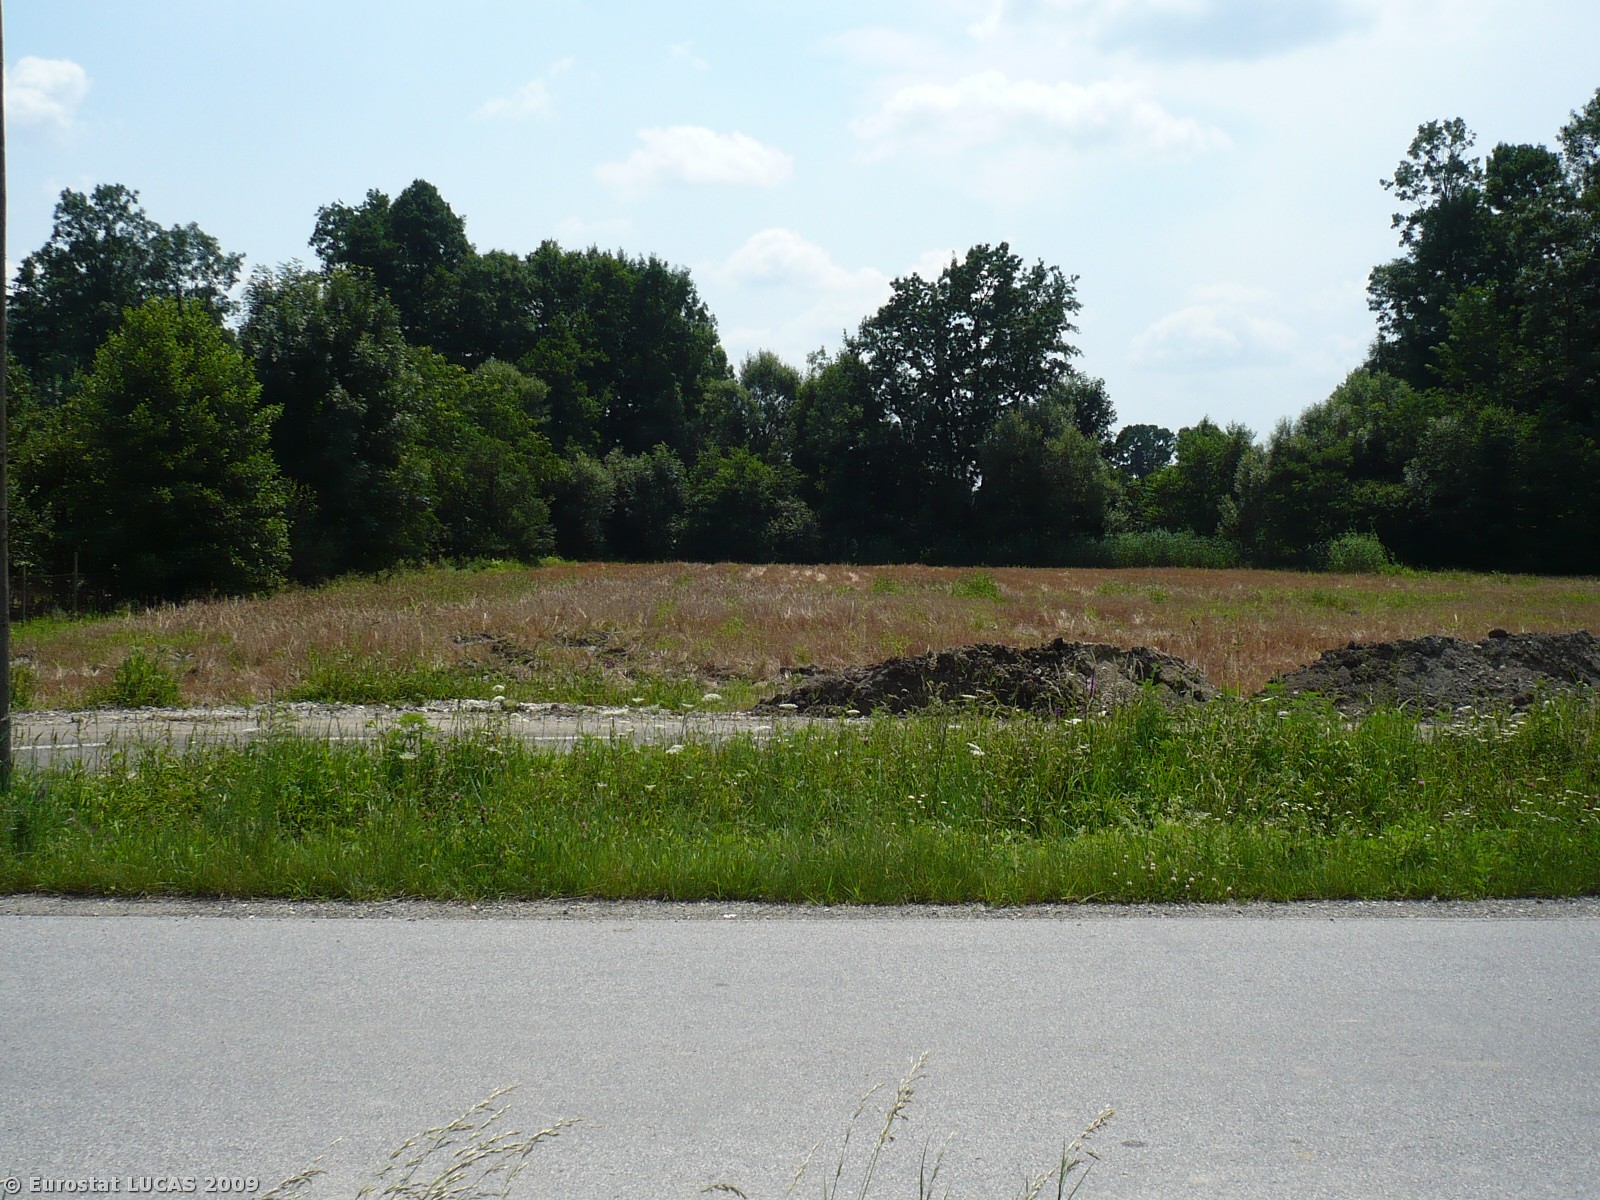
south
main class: Cropland
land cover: Common wheat
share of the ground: > 75 %
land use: Agriculture (excluding fallow land and kitchen gardens)
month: July
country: SI
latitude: 46.5776
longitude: 16.3557
